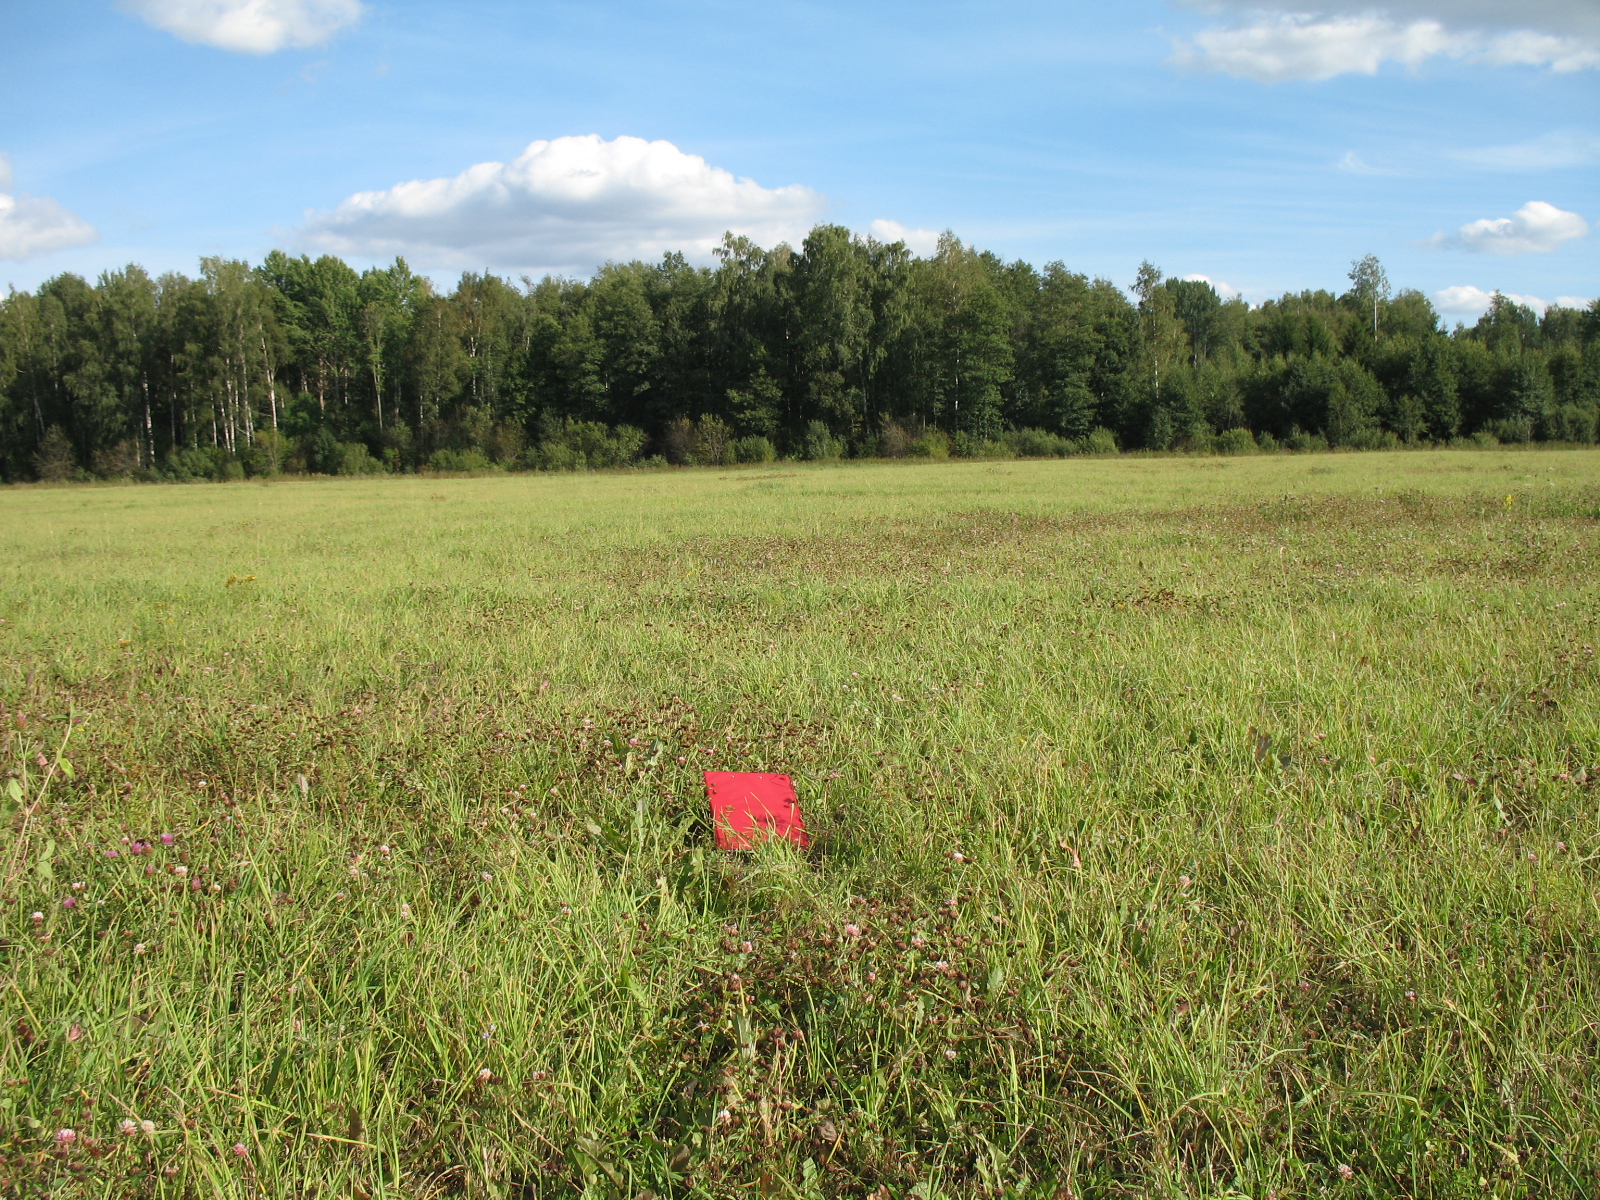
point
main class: Grassland
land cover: Grassland without tree/shrub cover
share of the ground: > 75 %
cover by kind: herbaceous plants 95 %, unconsolidated bare surface 5 %
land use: Agriculture (excluding fallow land and kitchen gardens)
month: August
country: LV
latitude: 56.2634
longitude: 26.1048
